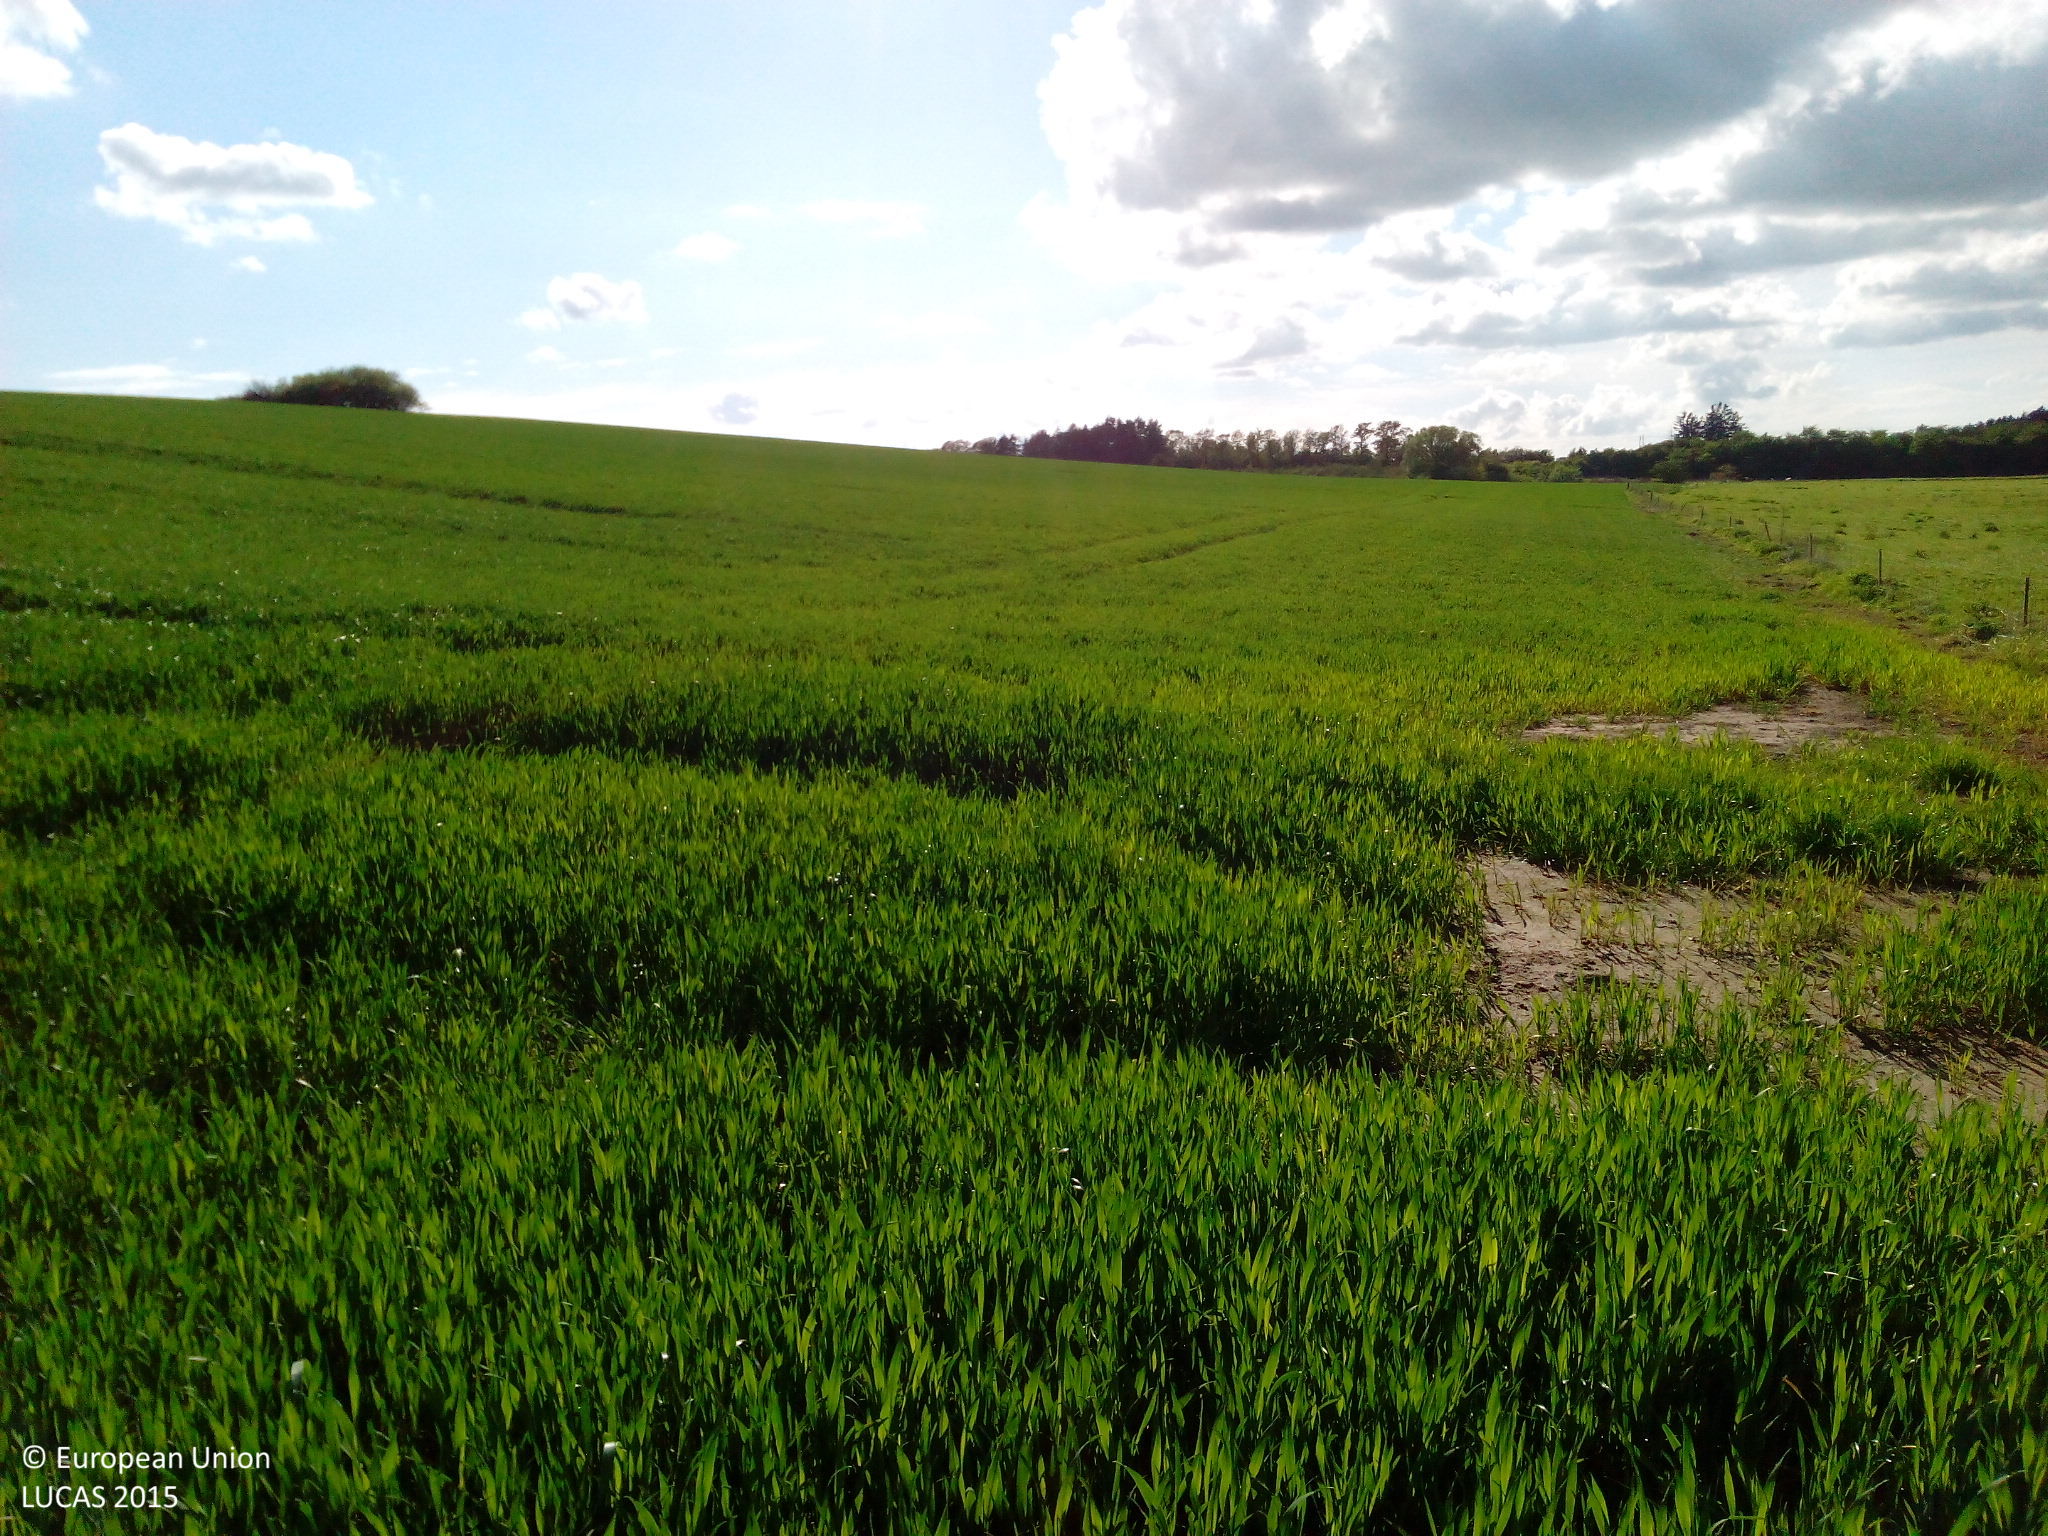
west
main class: Cropland
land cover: Common wheat
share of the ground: > 75 %
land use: Agriculture (excluding fallow land and kitchen gardens)
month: May
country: DK
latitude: 55.5781
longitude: 12.0445
